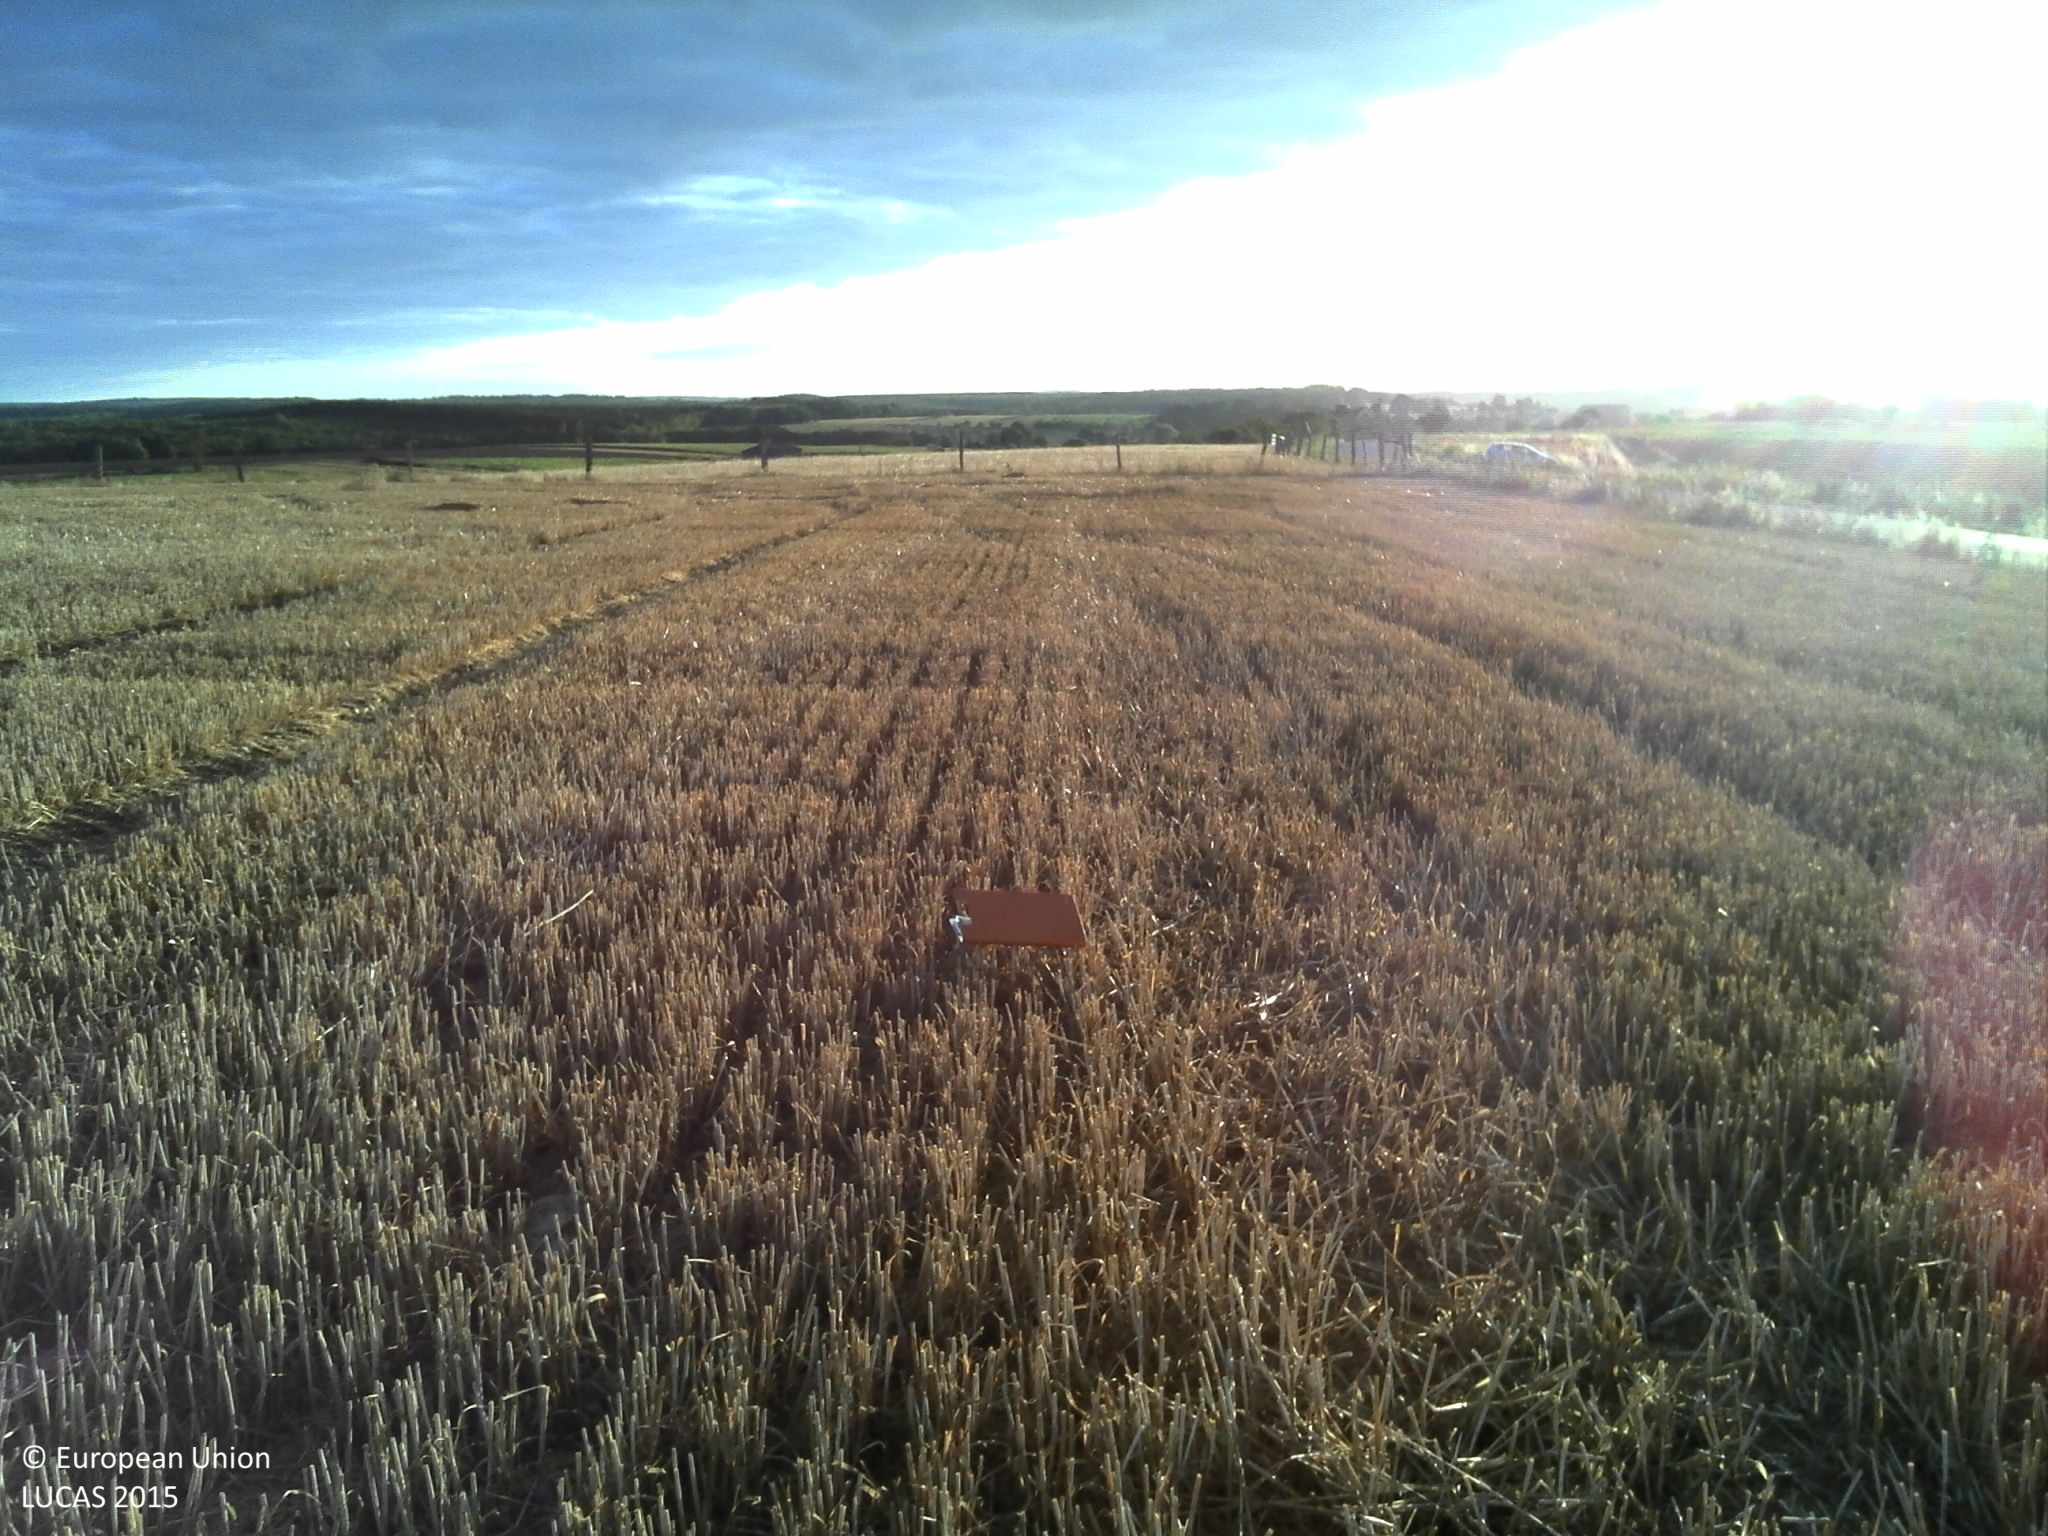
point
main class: Cropland
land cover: Durum wheat
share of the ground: < 10 %
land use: Agriculture (excluding fallow land and kitchen gardens)
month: July
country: FR
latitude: 48.2344
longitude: 6.3250
